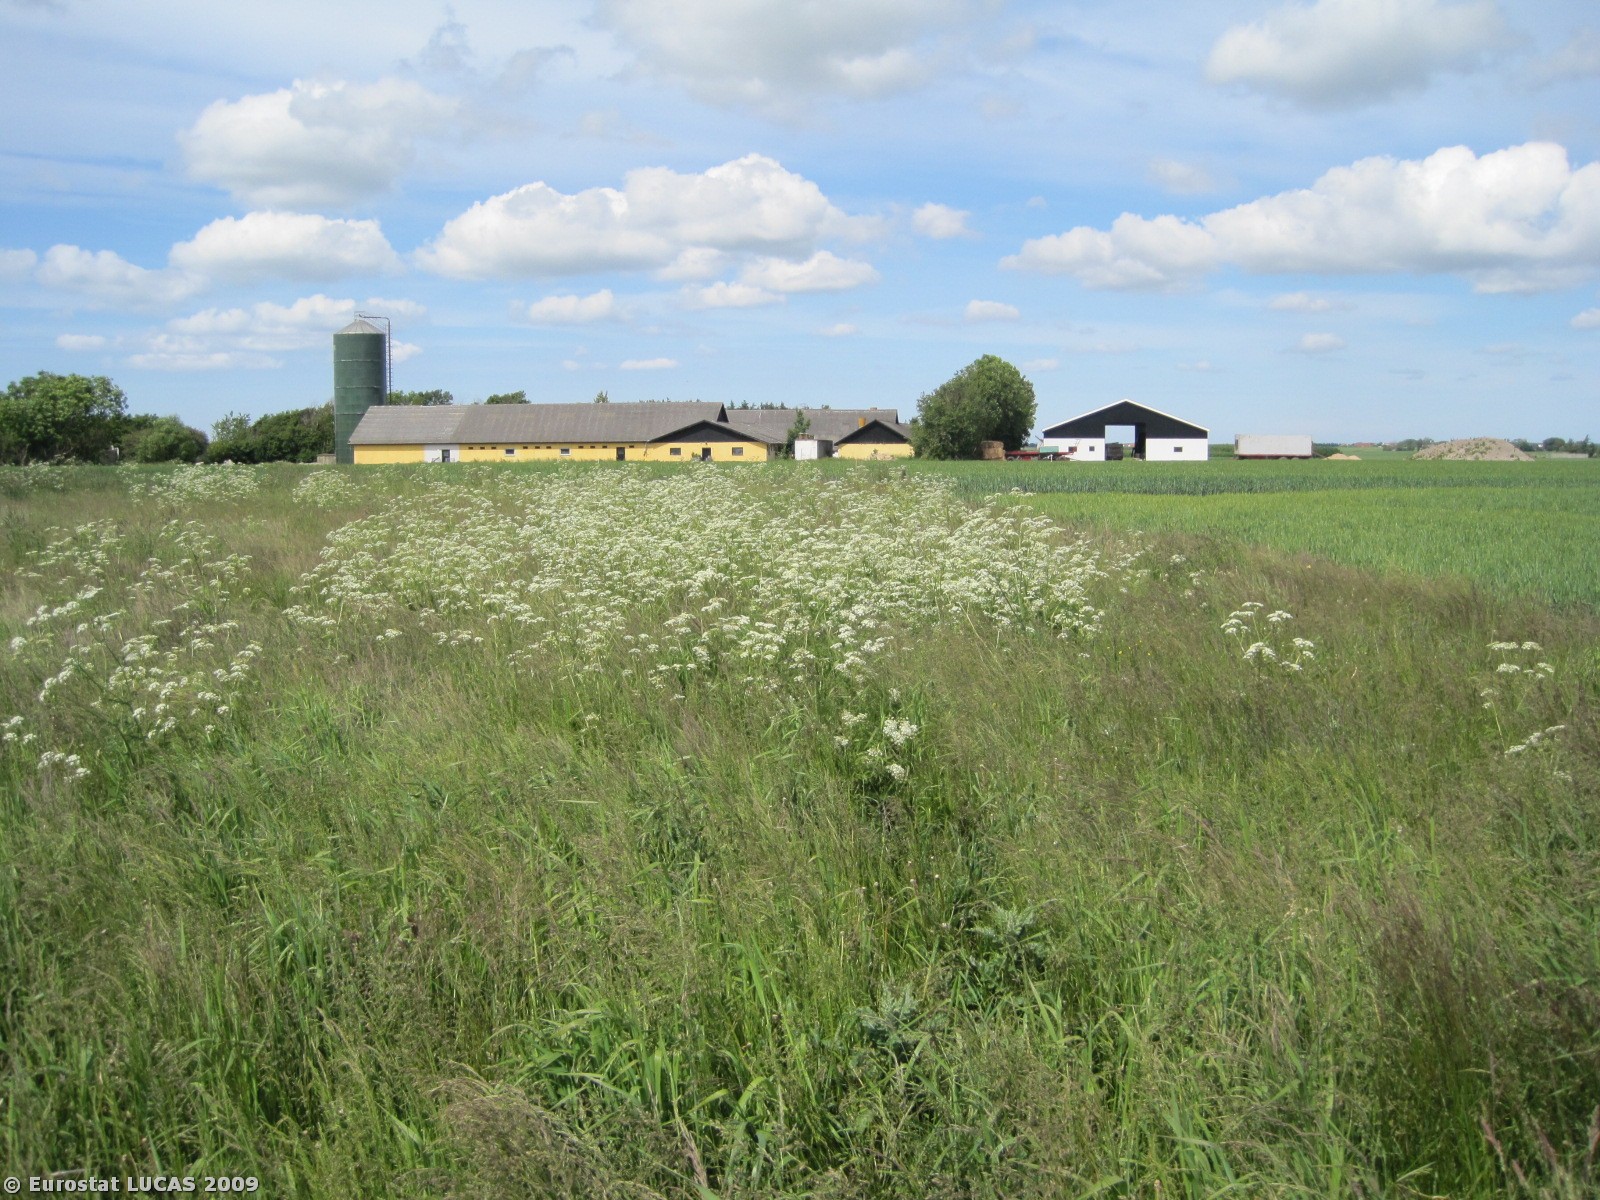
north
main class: Grassland
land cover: Grassland without tree/shrub cover
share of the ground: > 75 %
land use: Unused
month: June
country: DK
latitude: 57.3742
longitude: 9.8838
